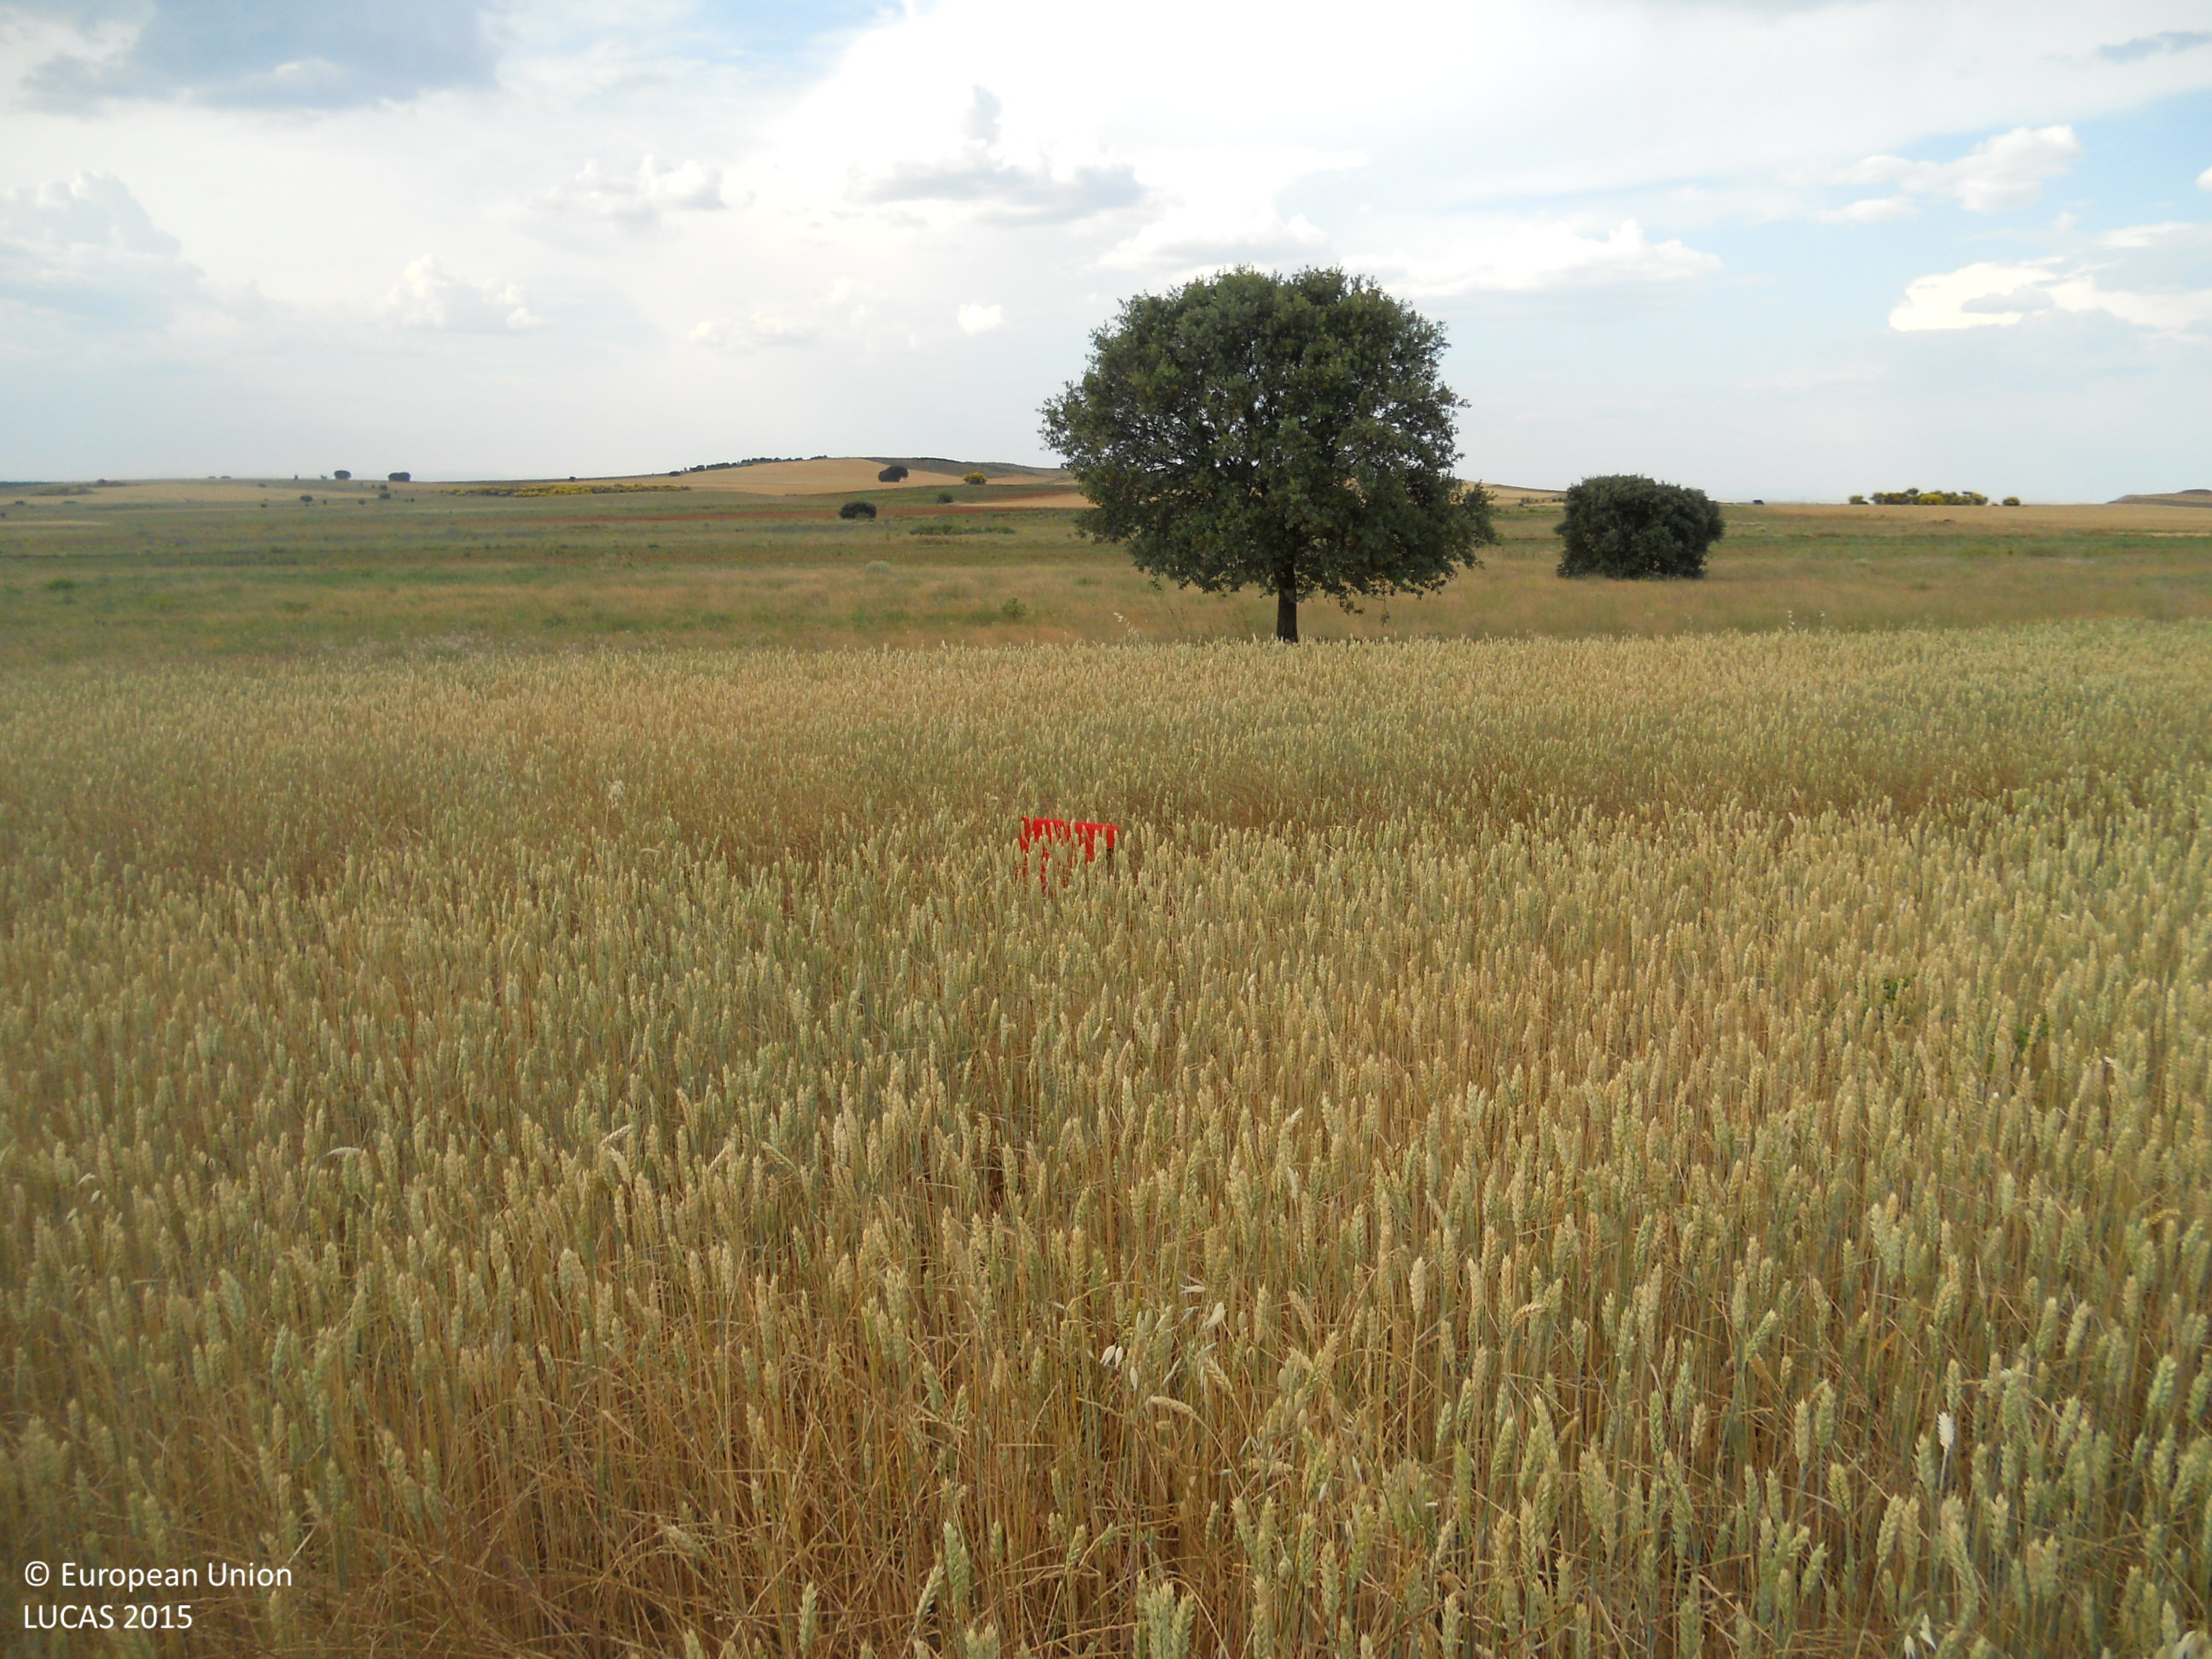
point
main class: Cropland
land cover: Common wheat
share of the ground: > 75 %
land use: Agriculture (excluding fallow land and kitchen gardens)
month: June
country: ES
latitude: 42.2064
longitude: -5.6085
